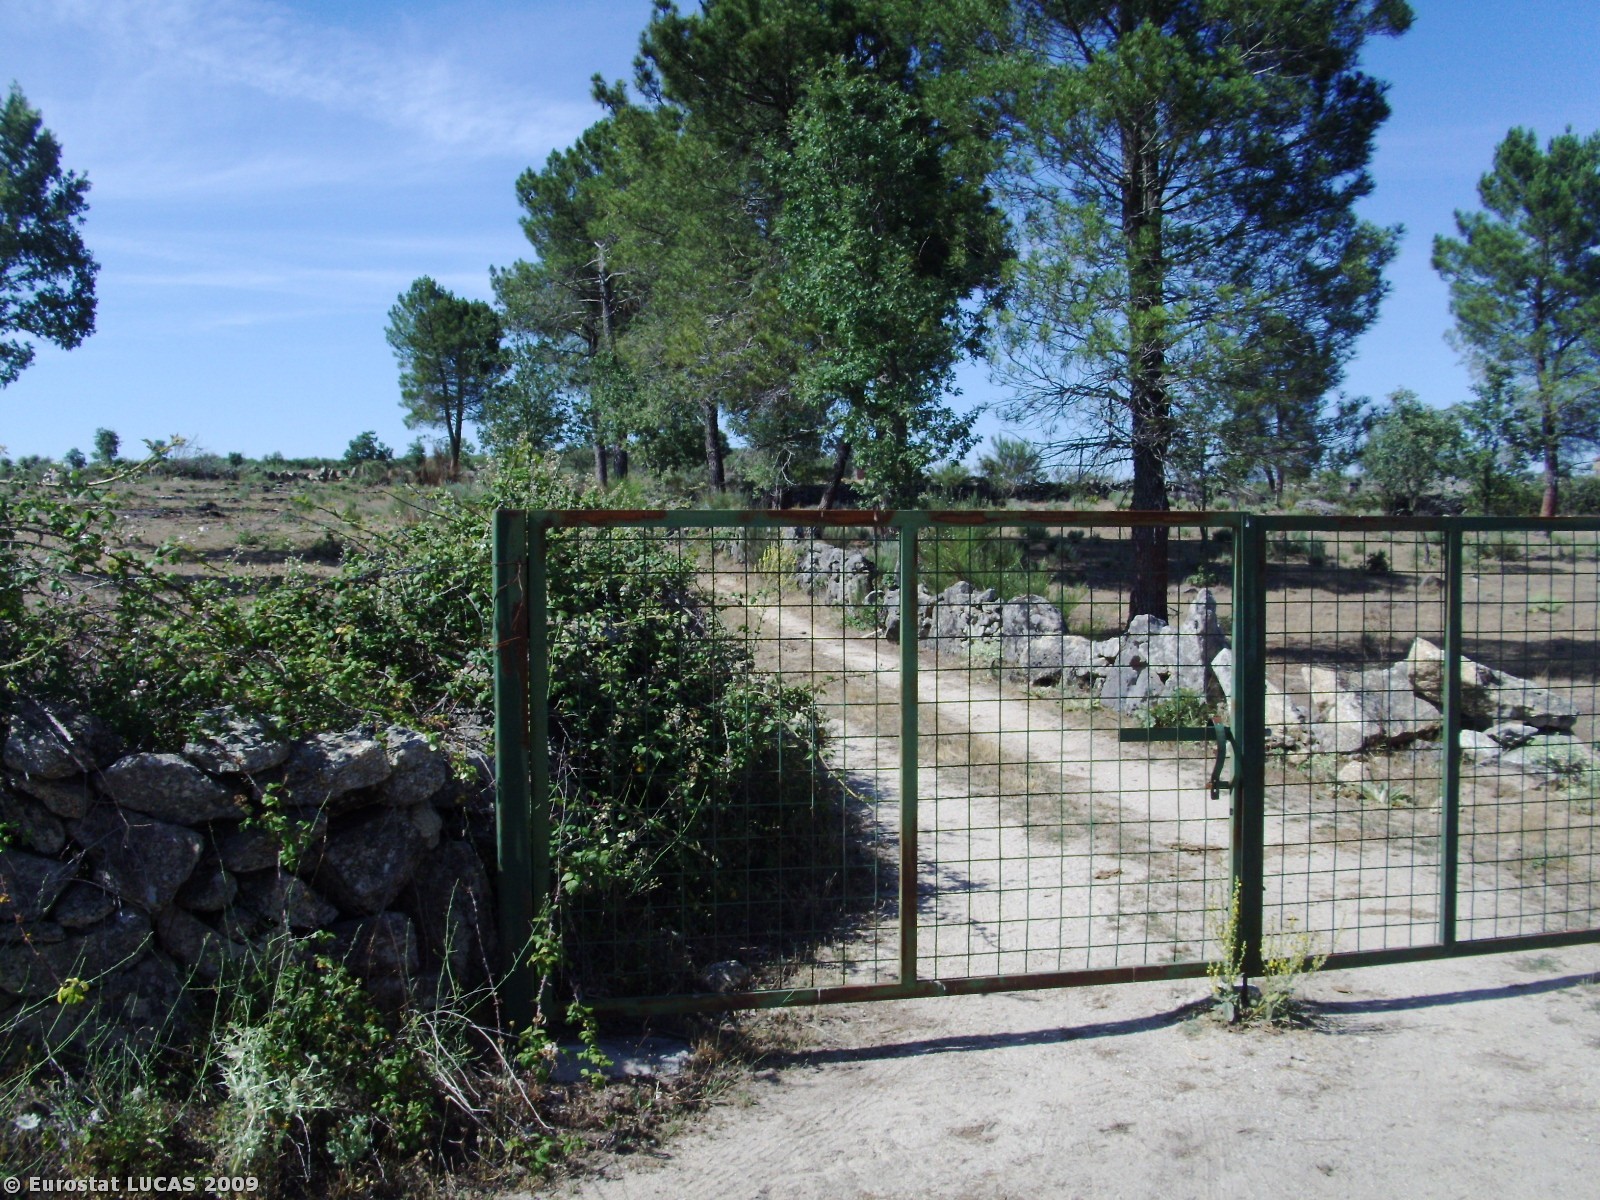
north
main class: Grassland
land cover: Spontaneously vegetated surfaces
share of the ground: > 75 %
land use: Fallow land
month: July
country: PT
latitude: 40.3726
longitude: -6.8046
